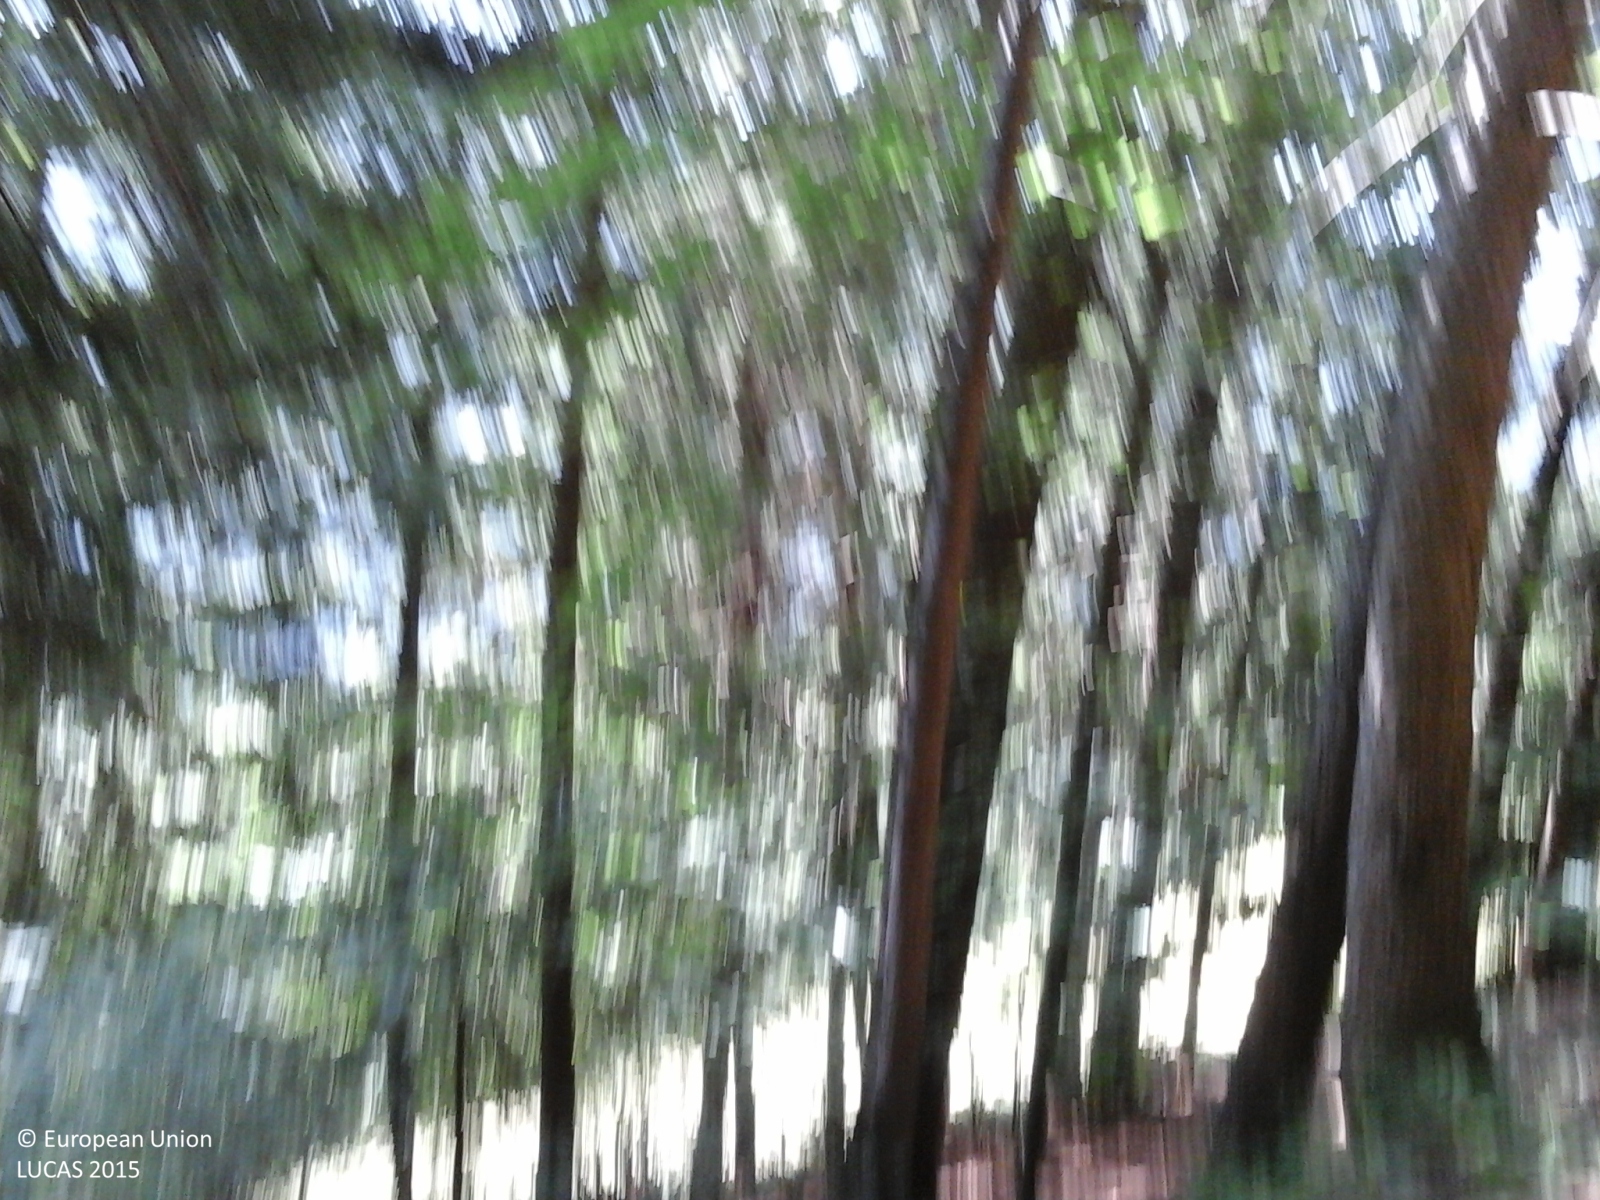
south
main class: Woodland
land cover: Spruce dominated coniferous woodland
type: alpine coniferous forest
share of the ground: > 75 %
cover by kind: coniferous forest trees 75 %, broadleaved forest trees 25 %
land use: Semi-natural and natural areas not in use
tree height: > 5 m
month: July
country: IT
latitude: 46.0089
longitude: 10.1161
